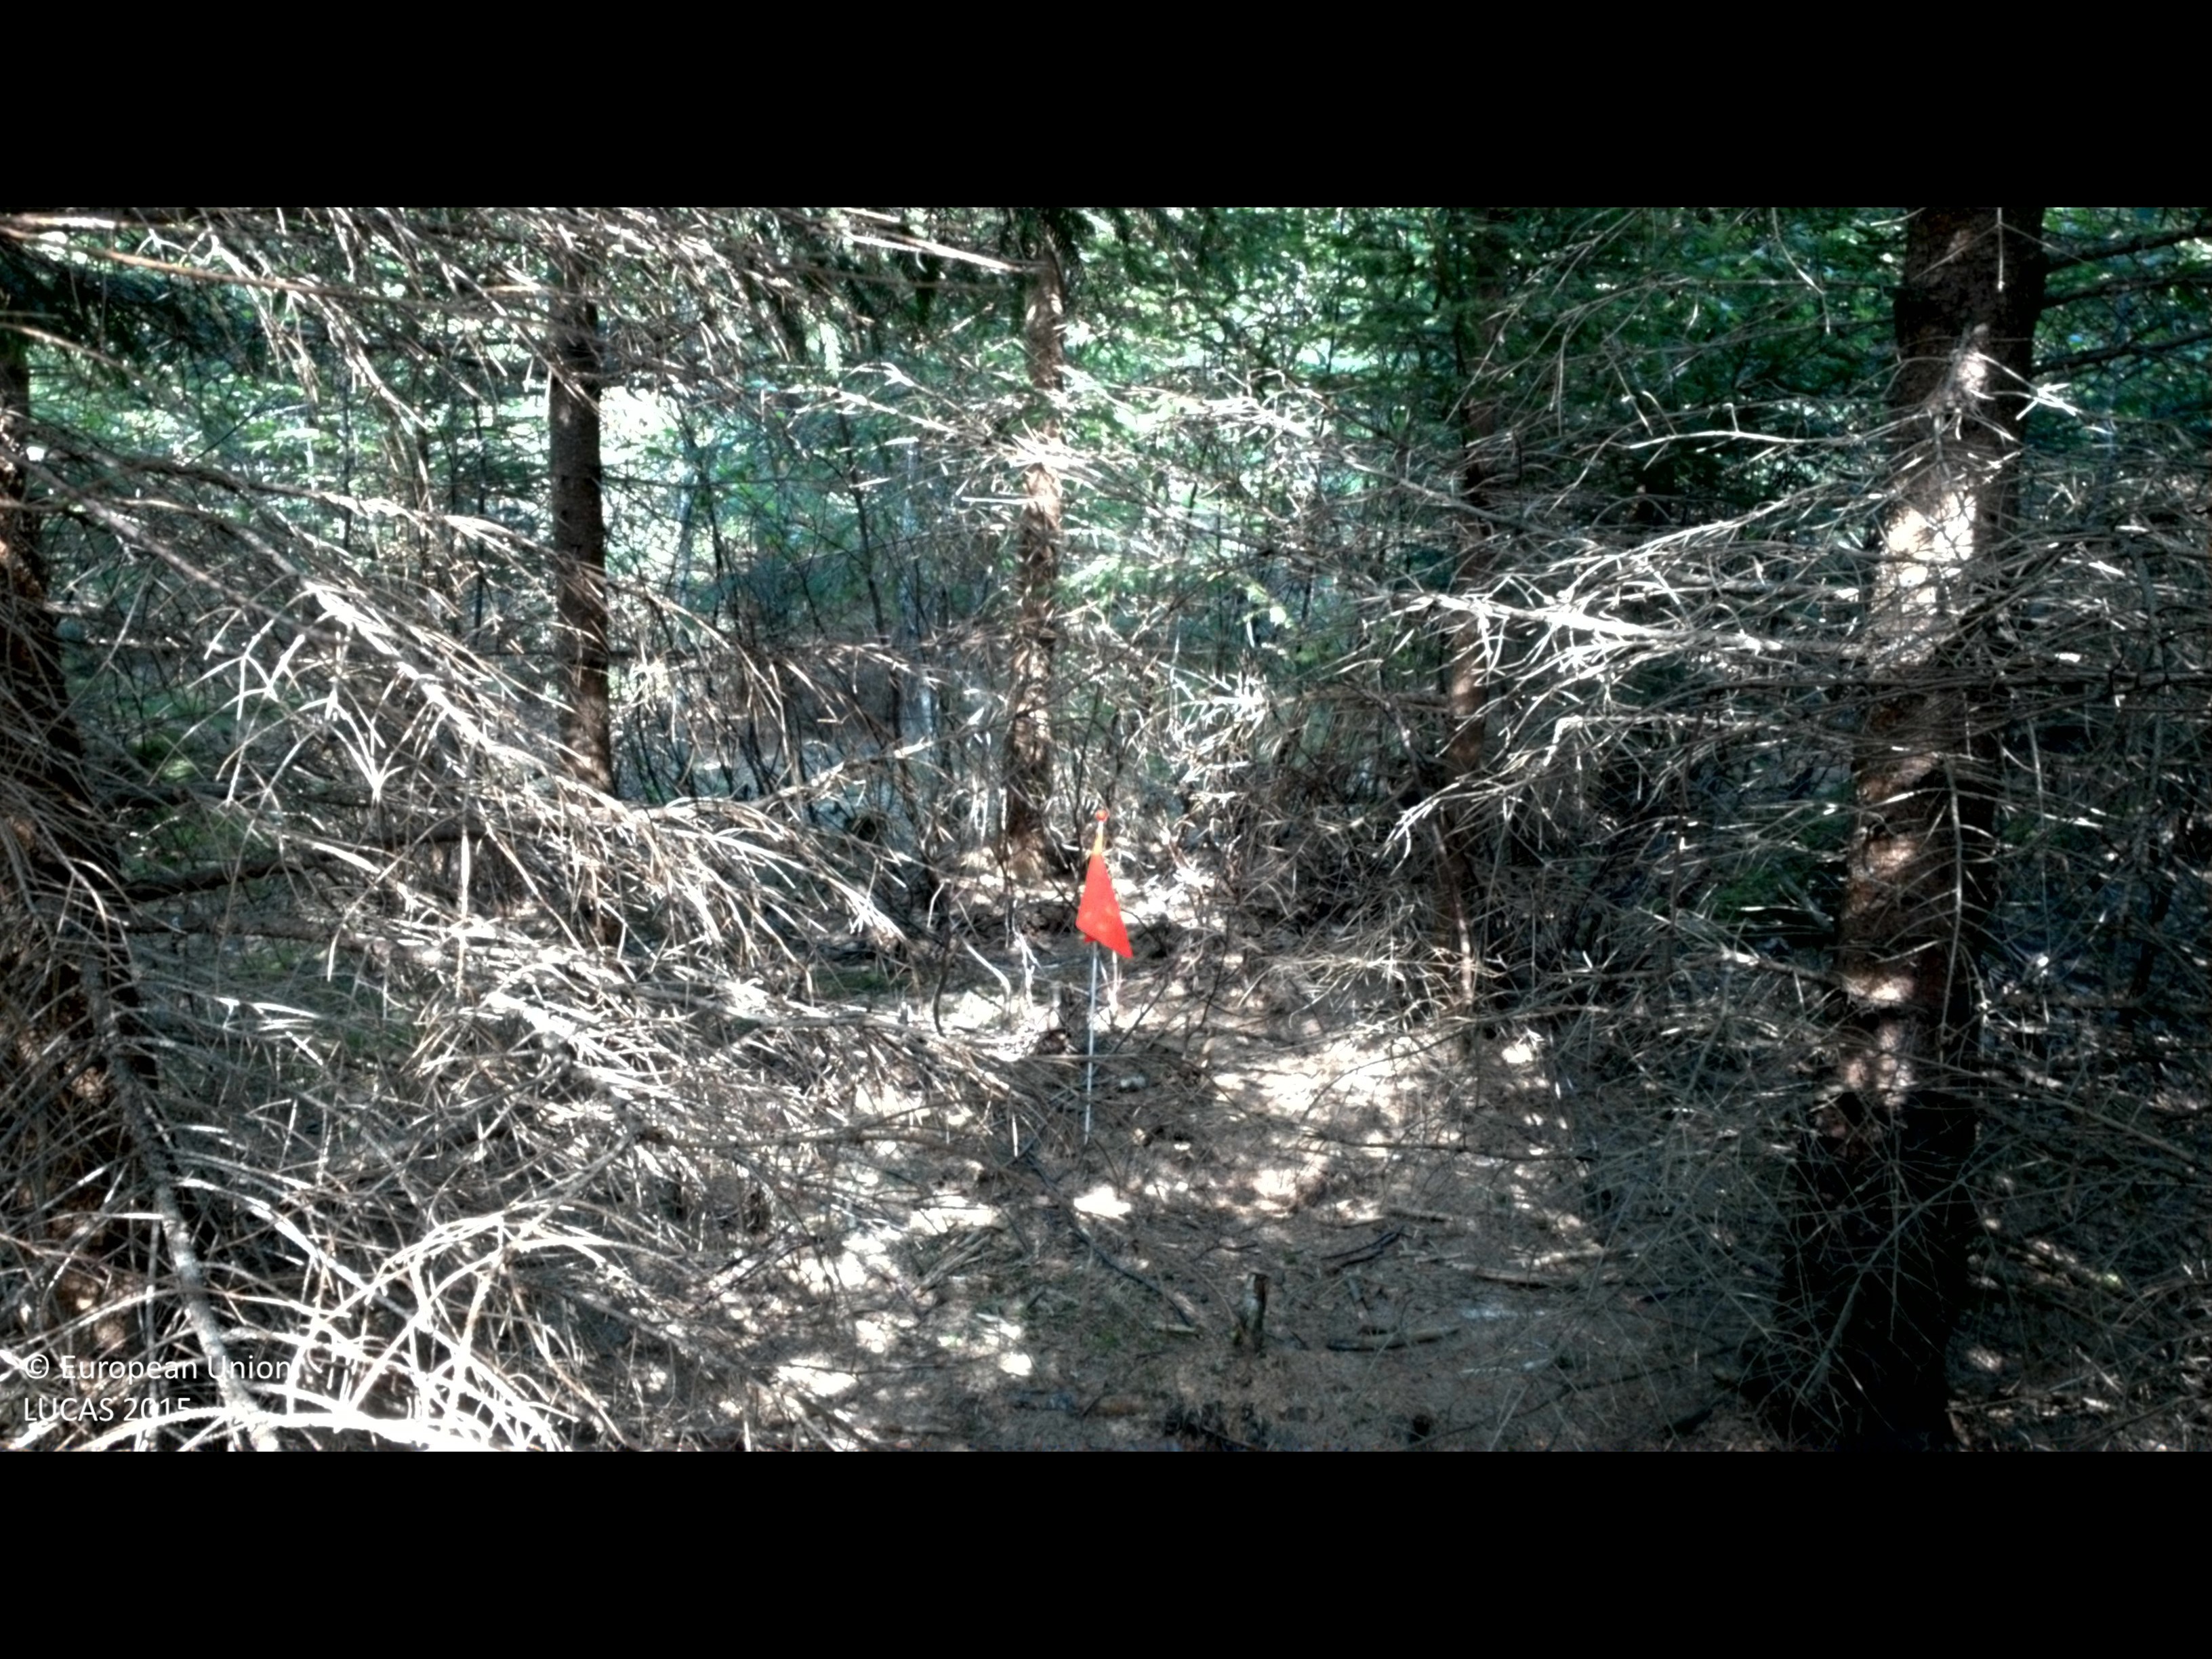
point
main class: Woodland
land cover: Spruce dominated coniferous woodland
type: boreal forest
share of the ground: > 75 %
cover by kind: coniferous forest trees 75 %, broadleaved forest trees 15 %, shrubs 5 %, lichens and mosses 5 %
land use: Forestry
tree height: > 5 m
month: July
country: SE
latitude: 58.3067
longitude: 16.6698
